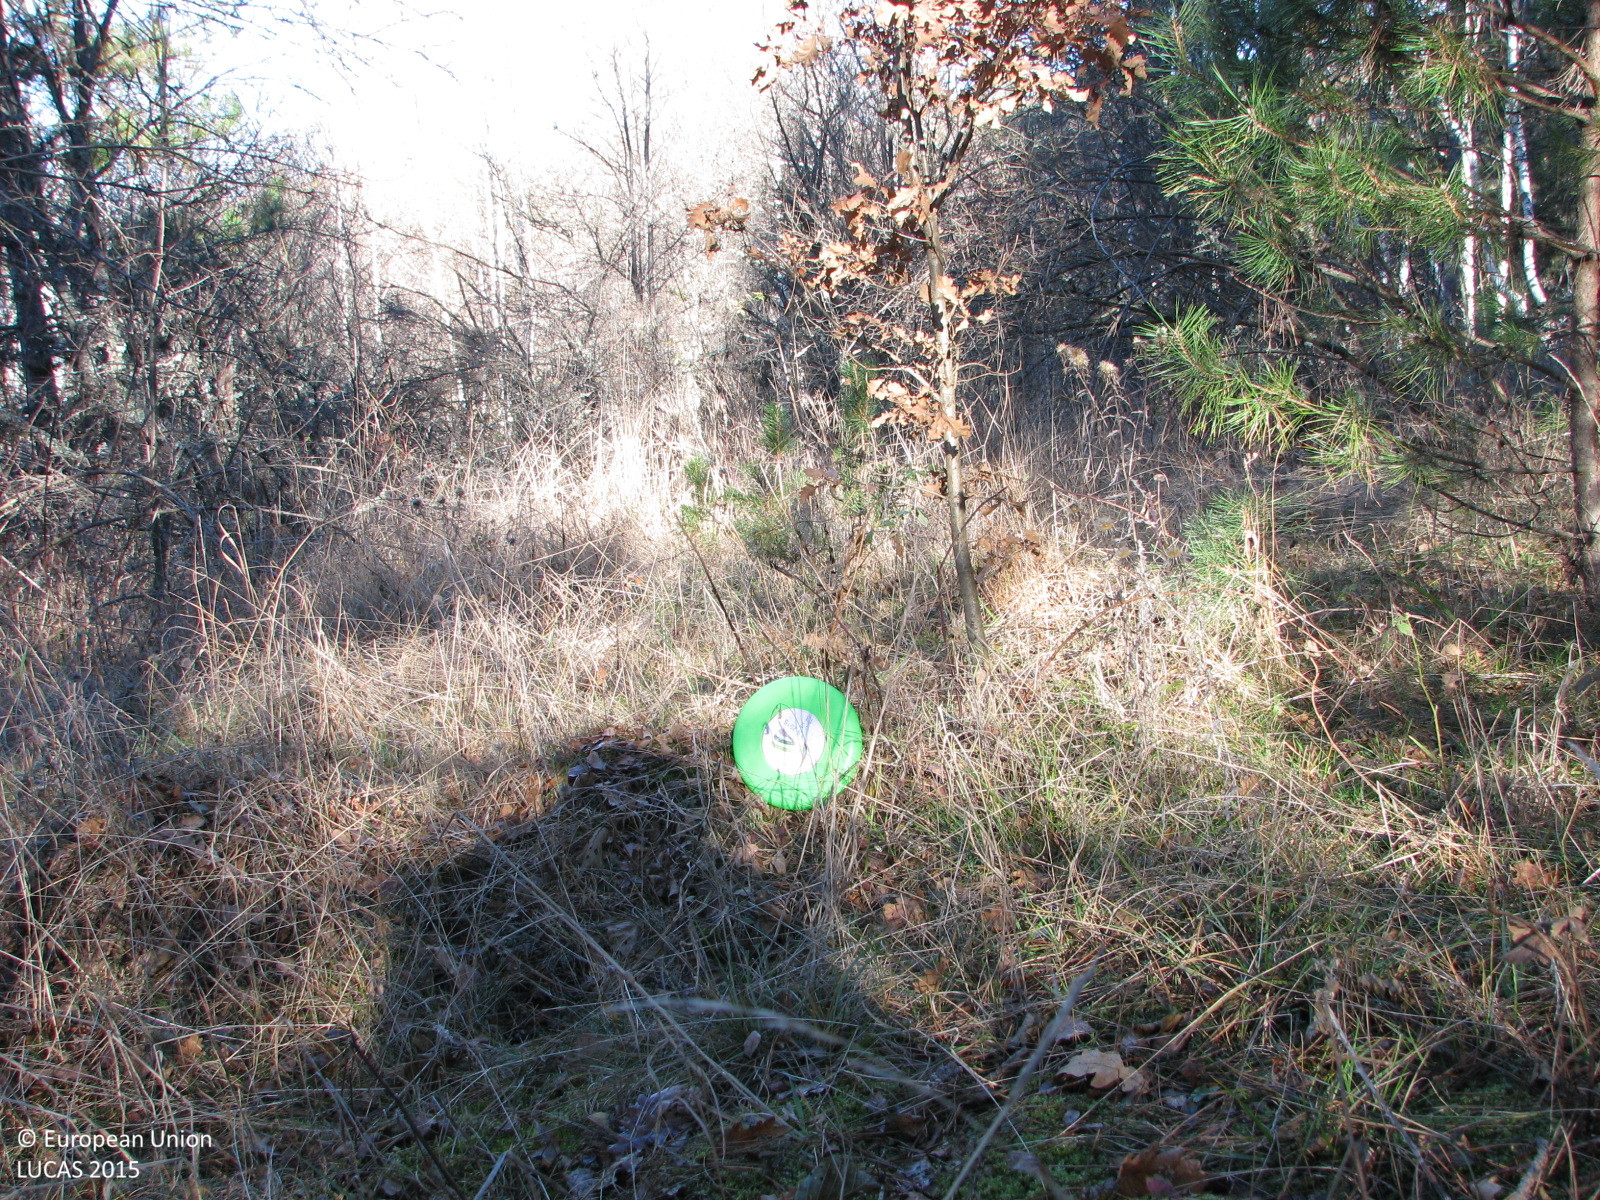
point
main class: Woodland
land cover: Pine dominated mixed woodland
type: hemiboreal forest and nemoral coniferous forest and mixed broadleaved-coniferous forest
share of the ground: > 75 %
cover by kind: coniferous forest trees 60 %, broadleaved forest trees 20 %, herbaceous plants 15 %, shrubs 5 %
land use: Forestry
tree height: > 5 m
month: December
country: BG
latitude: 42.4956
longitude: 25.0393
